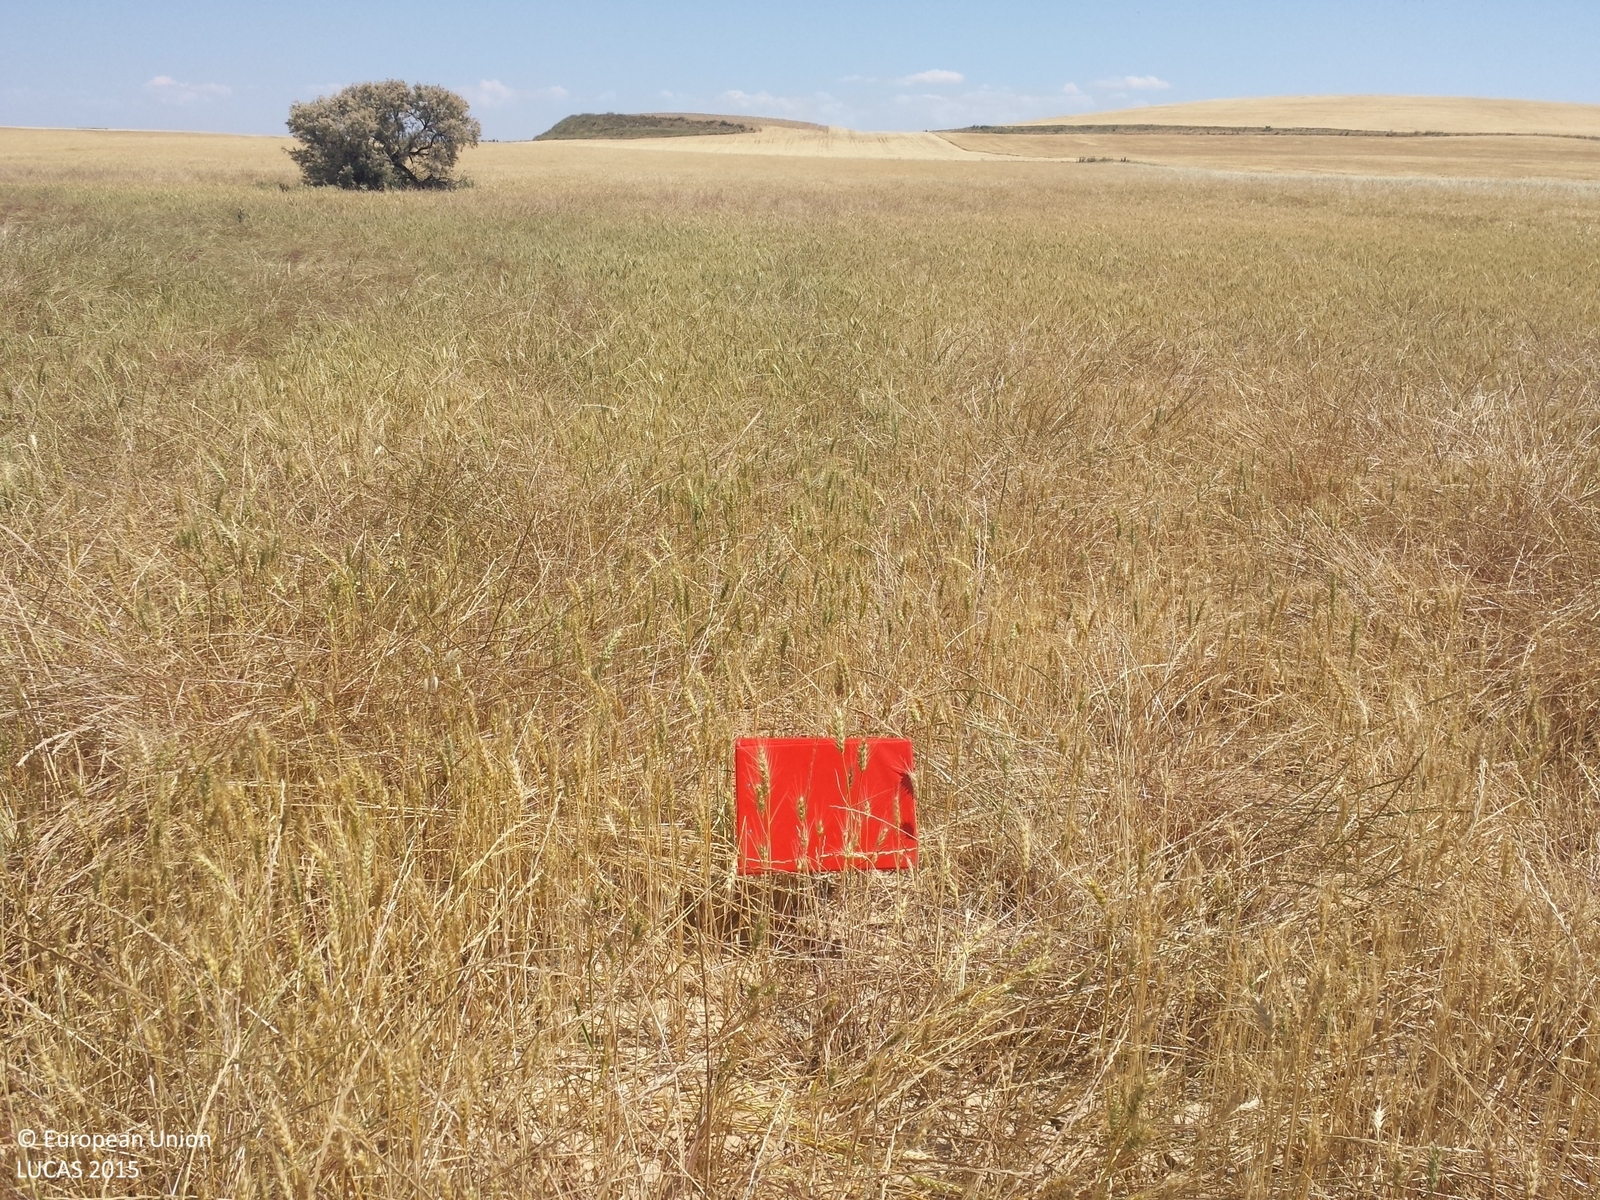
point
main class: Cropland
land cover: Common wheat
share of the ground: > 75 %
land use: Agriculture (excluding fallow land and kitchen gardens)
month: May
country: ES
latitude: 41.7564
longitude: 0.5450
